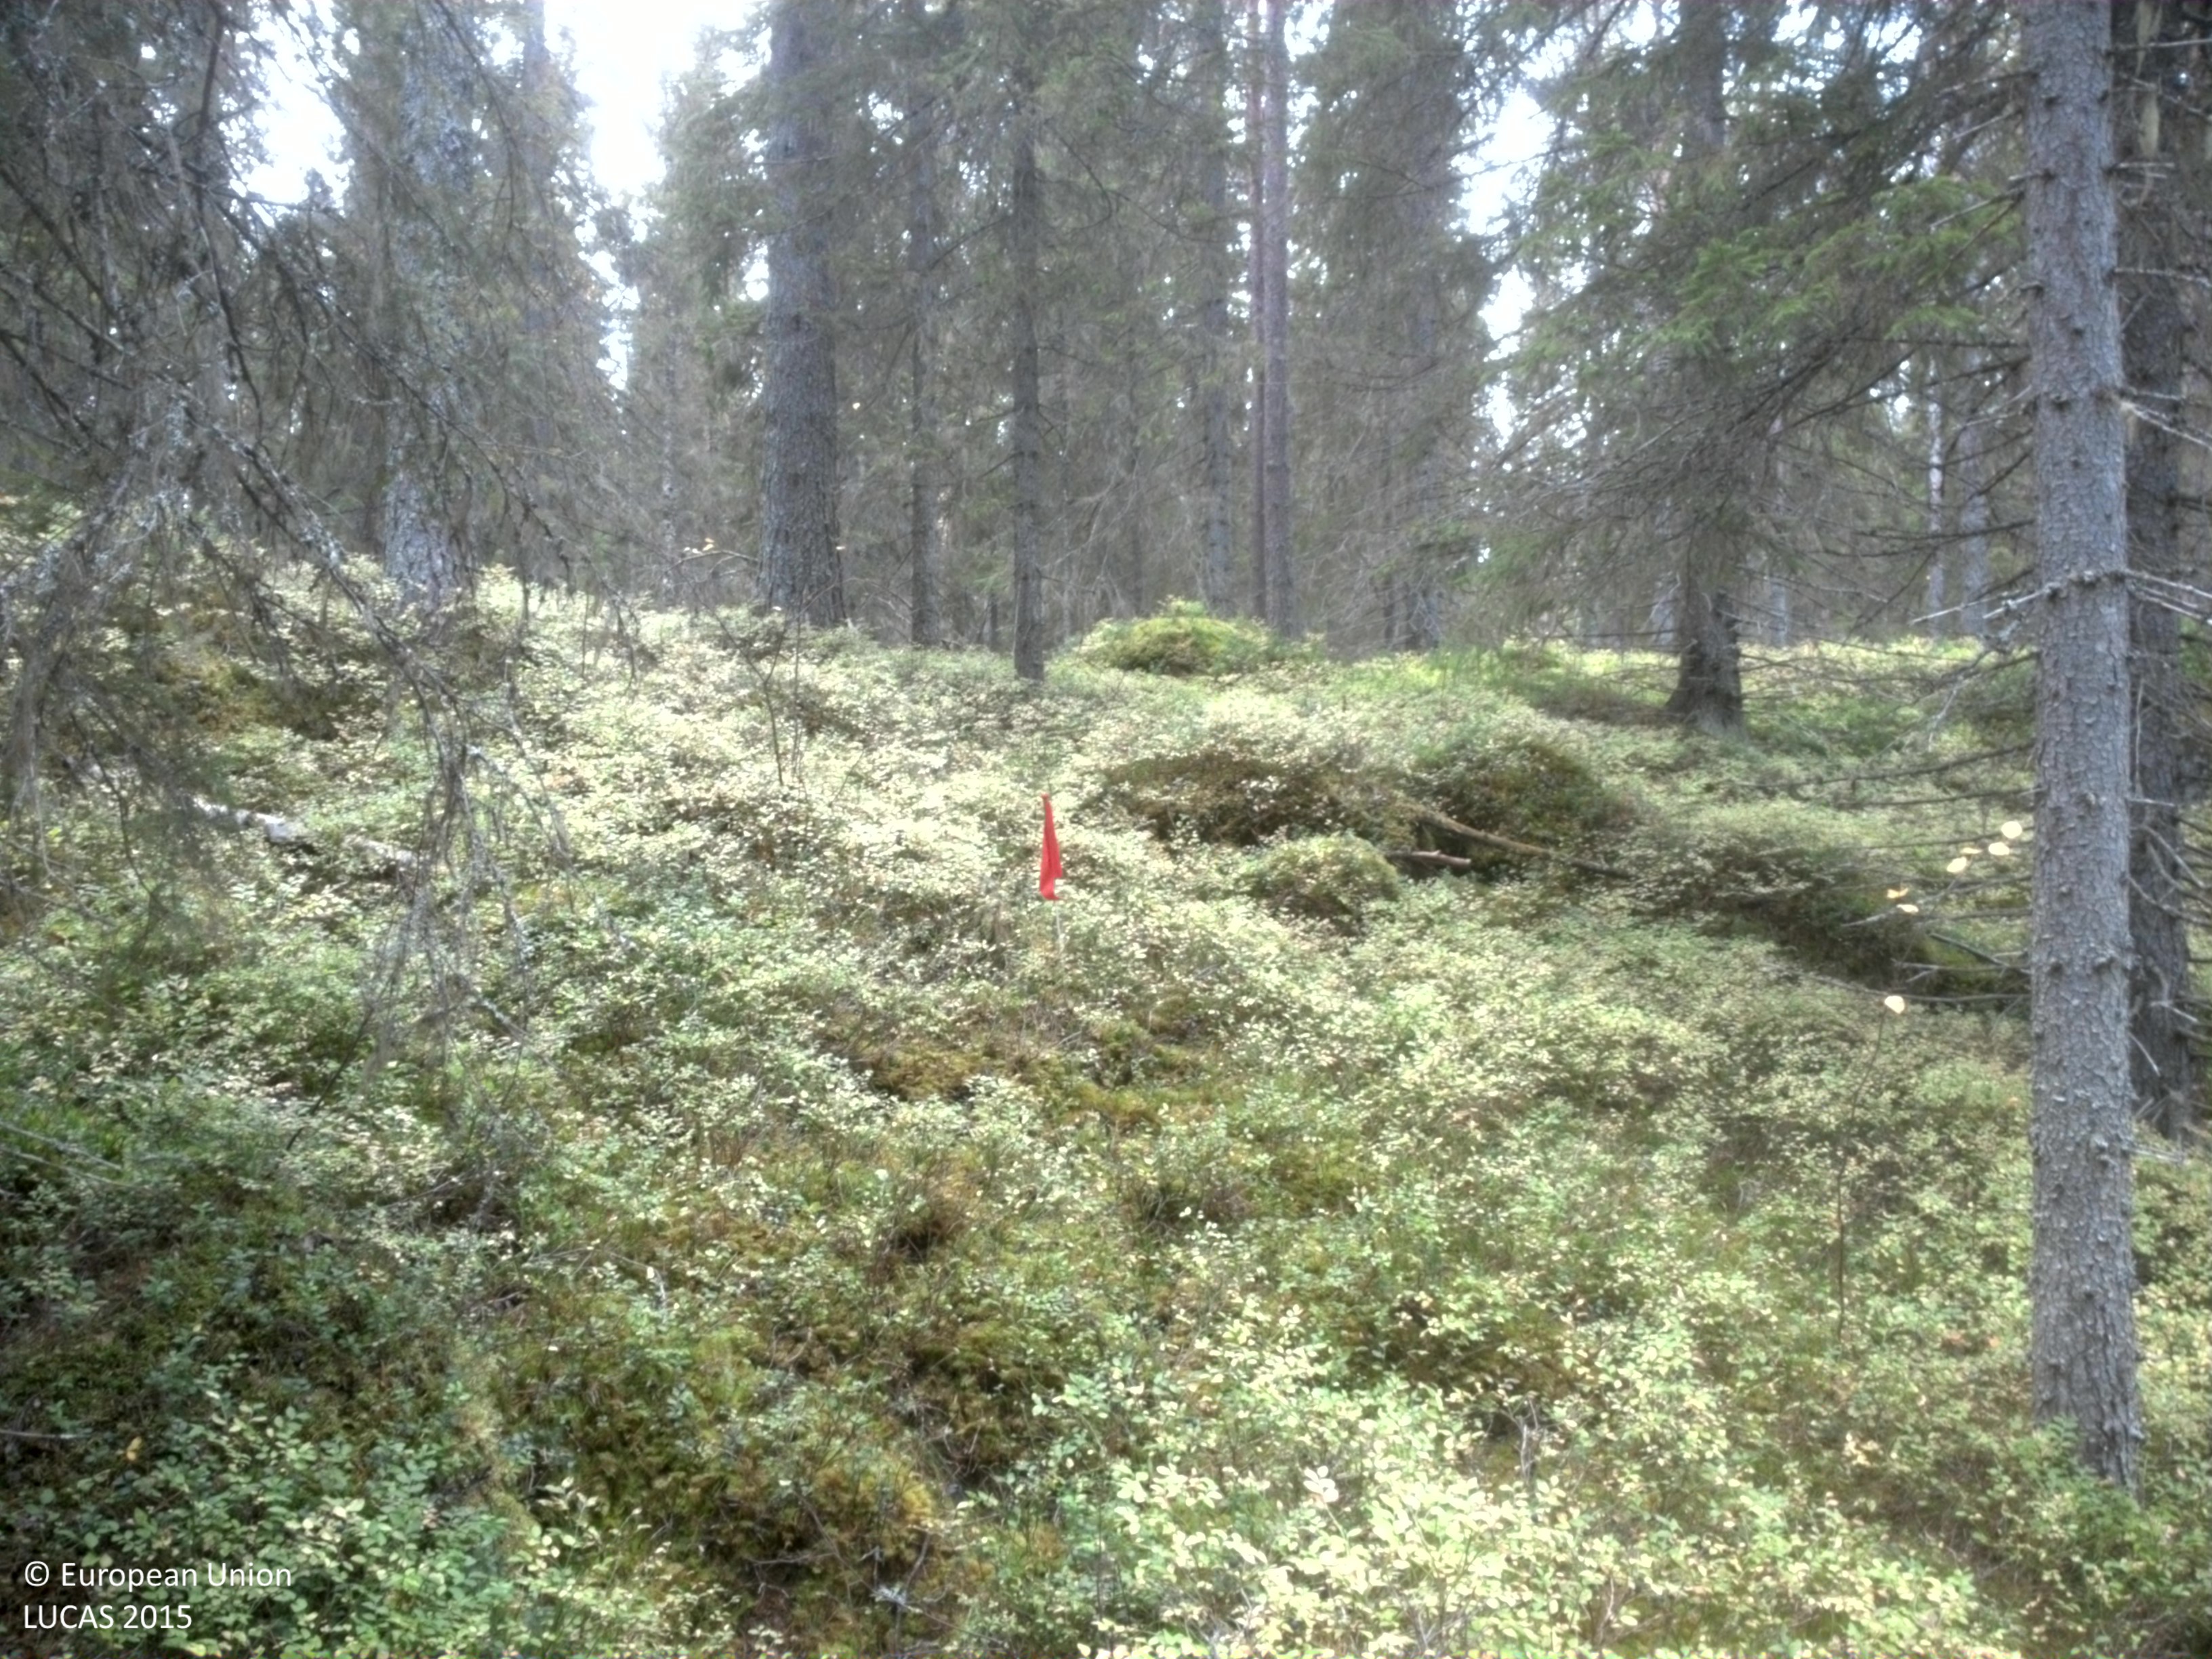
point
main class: Woodland
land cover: Spruce dominated coniferous woodland
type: boreal forest
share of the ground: 50 - 75 %
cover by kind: coniferous forest trees 60 %, shrubs 30 %, lichens and mosses 10 %
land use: Forestry
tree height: > 5 m
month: September
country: SE
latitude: 64.3437
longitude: 20.1819
